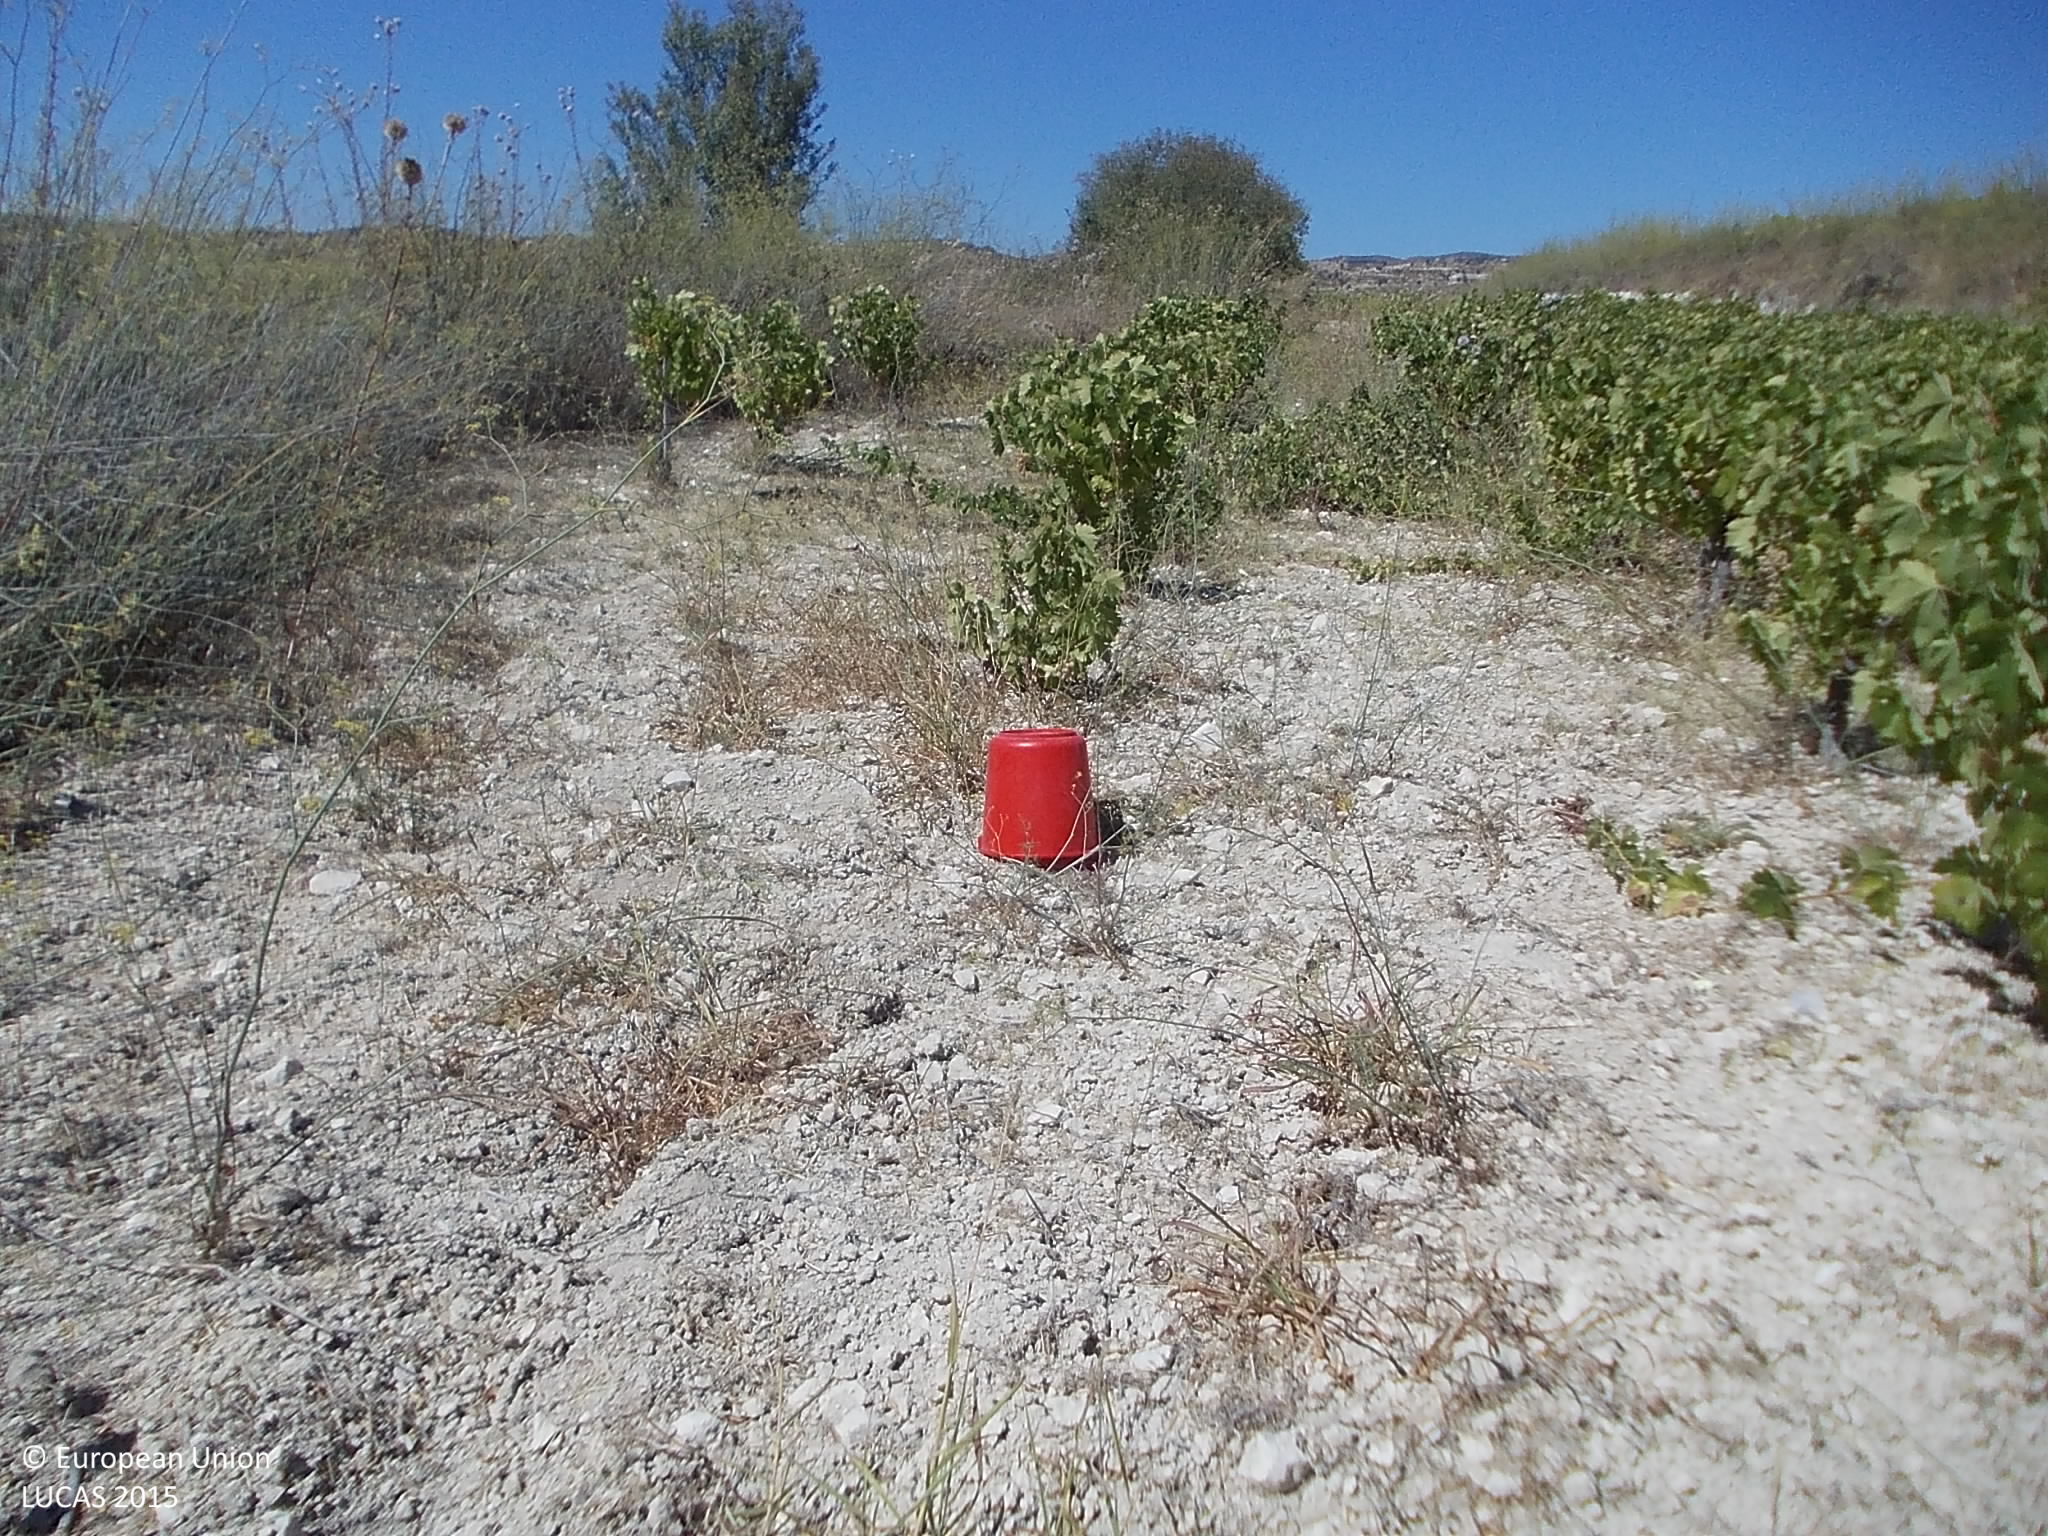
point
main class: Cropland
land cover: Vineyards
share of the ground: 25 - 50 %
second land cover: Other bare soil
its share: > 75 %
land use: Agriculture (excluding fallow land and kitchen gardens)
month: May
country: CY
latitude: 34.7905
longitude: 32.7928
